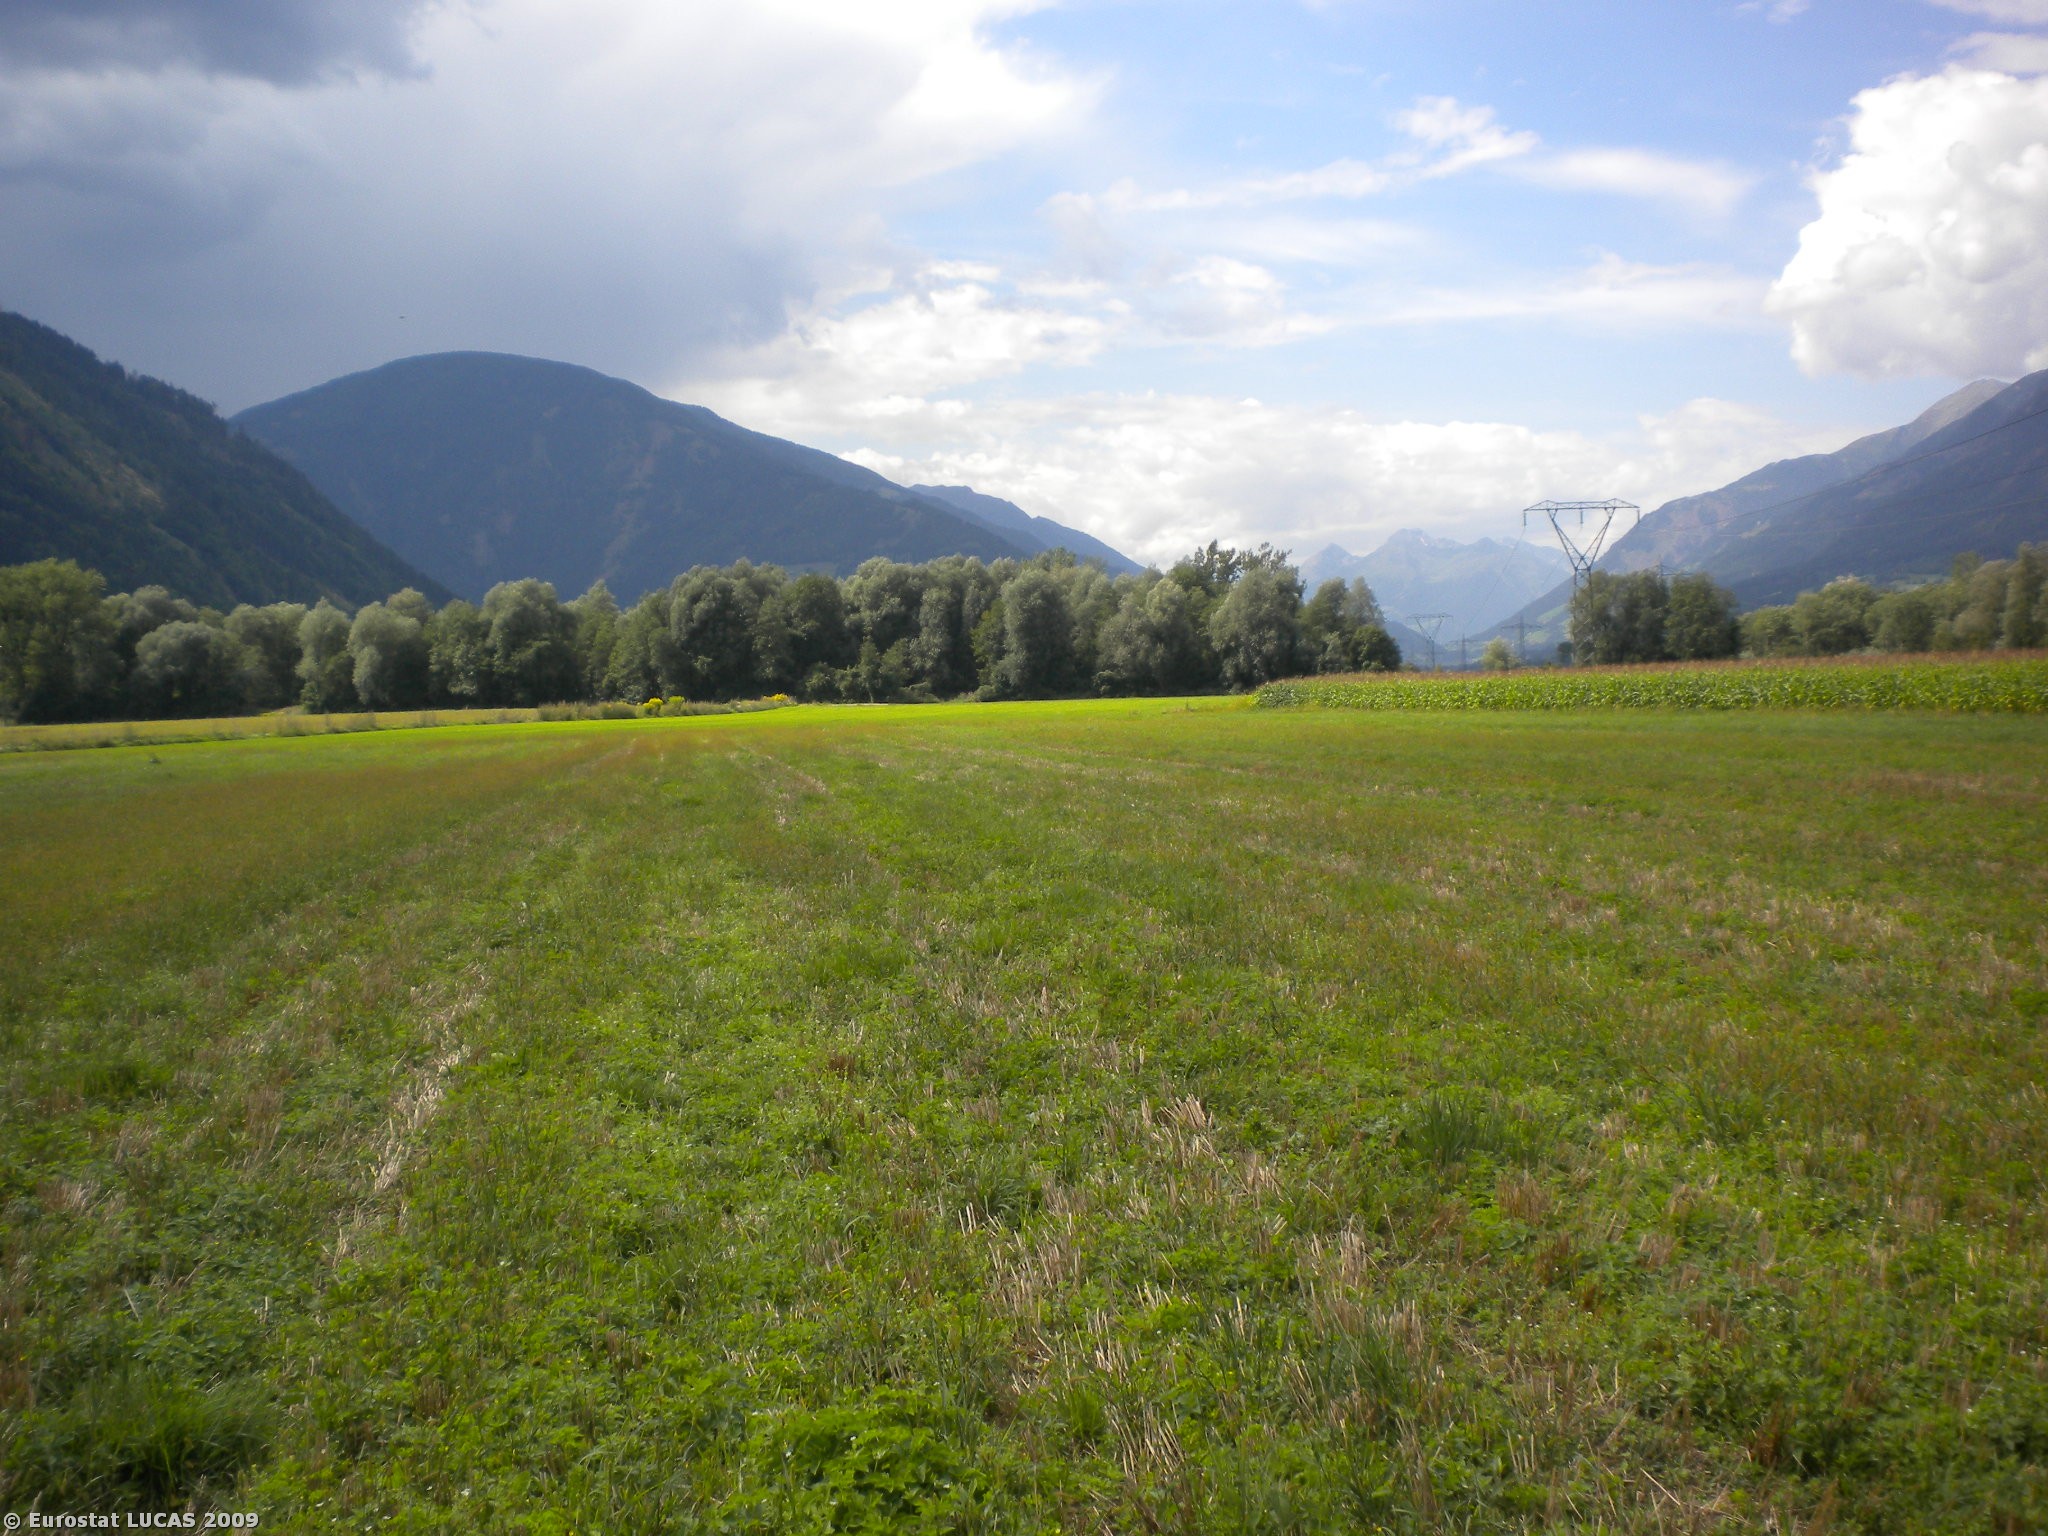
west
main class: Grassland
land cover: Grassland without tree/shrub cover
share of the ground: > 75 %
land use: Agriculture (excluding fallow land and kitchen gardens)
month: August
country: AT
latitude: 46.8193
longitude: 13.4184
